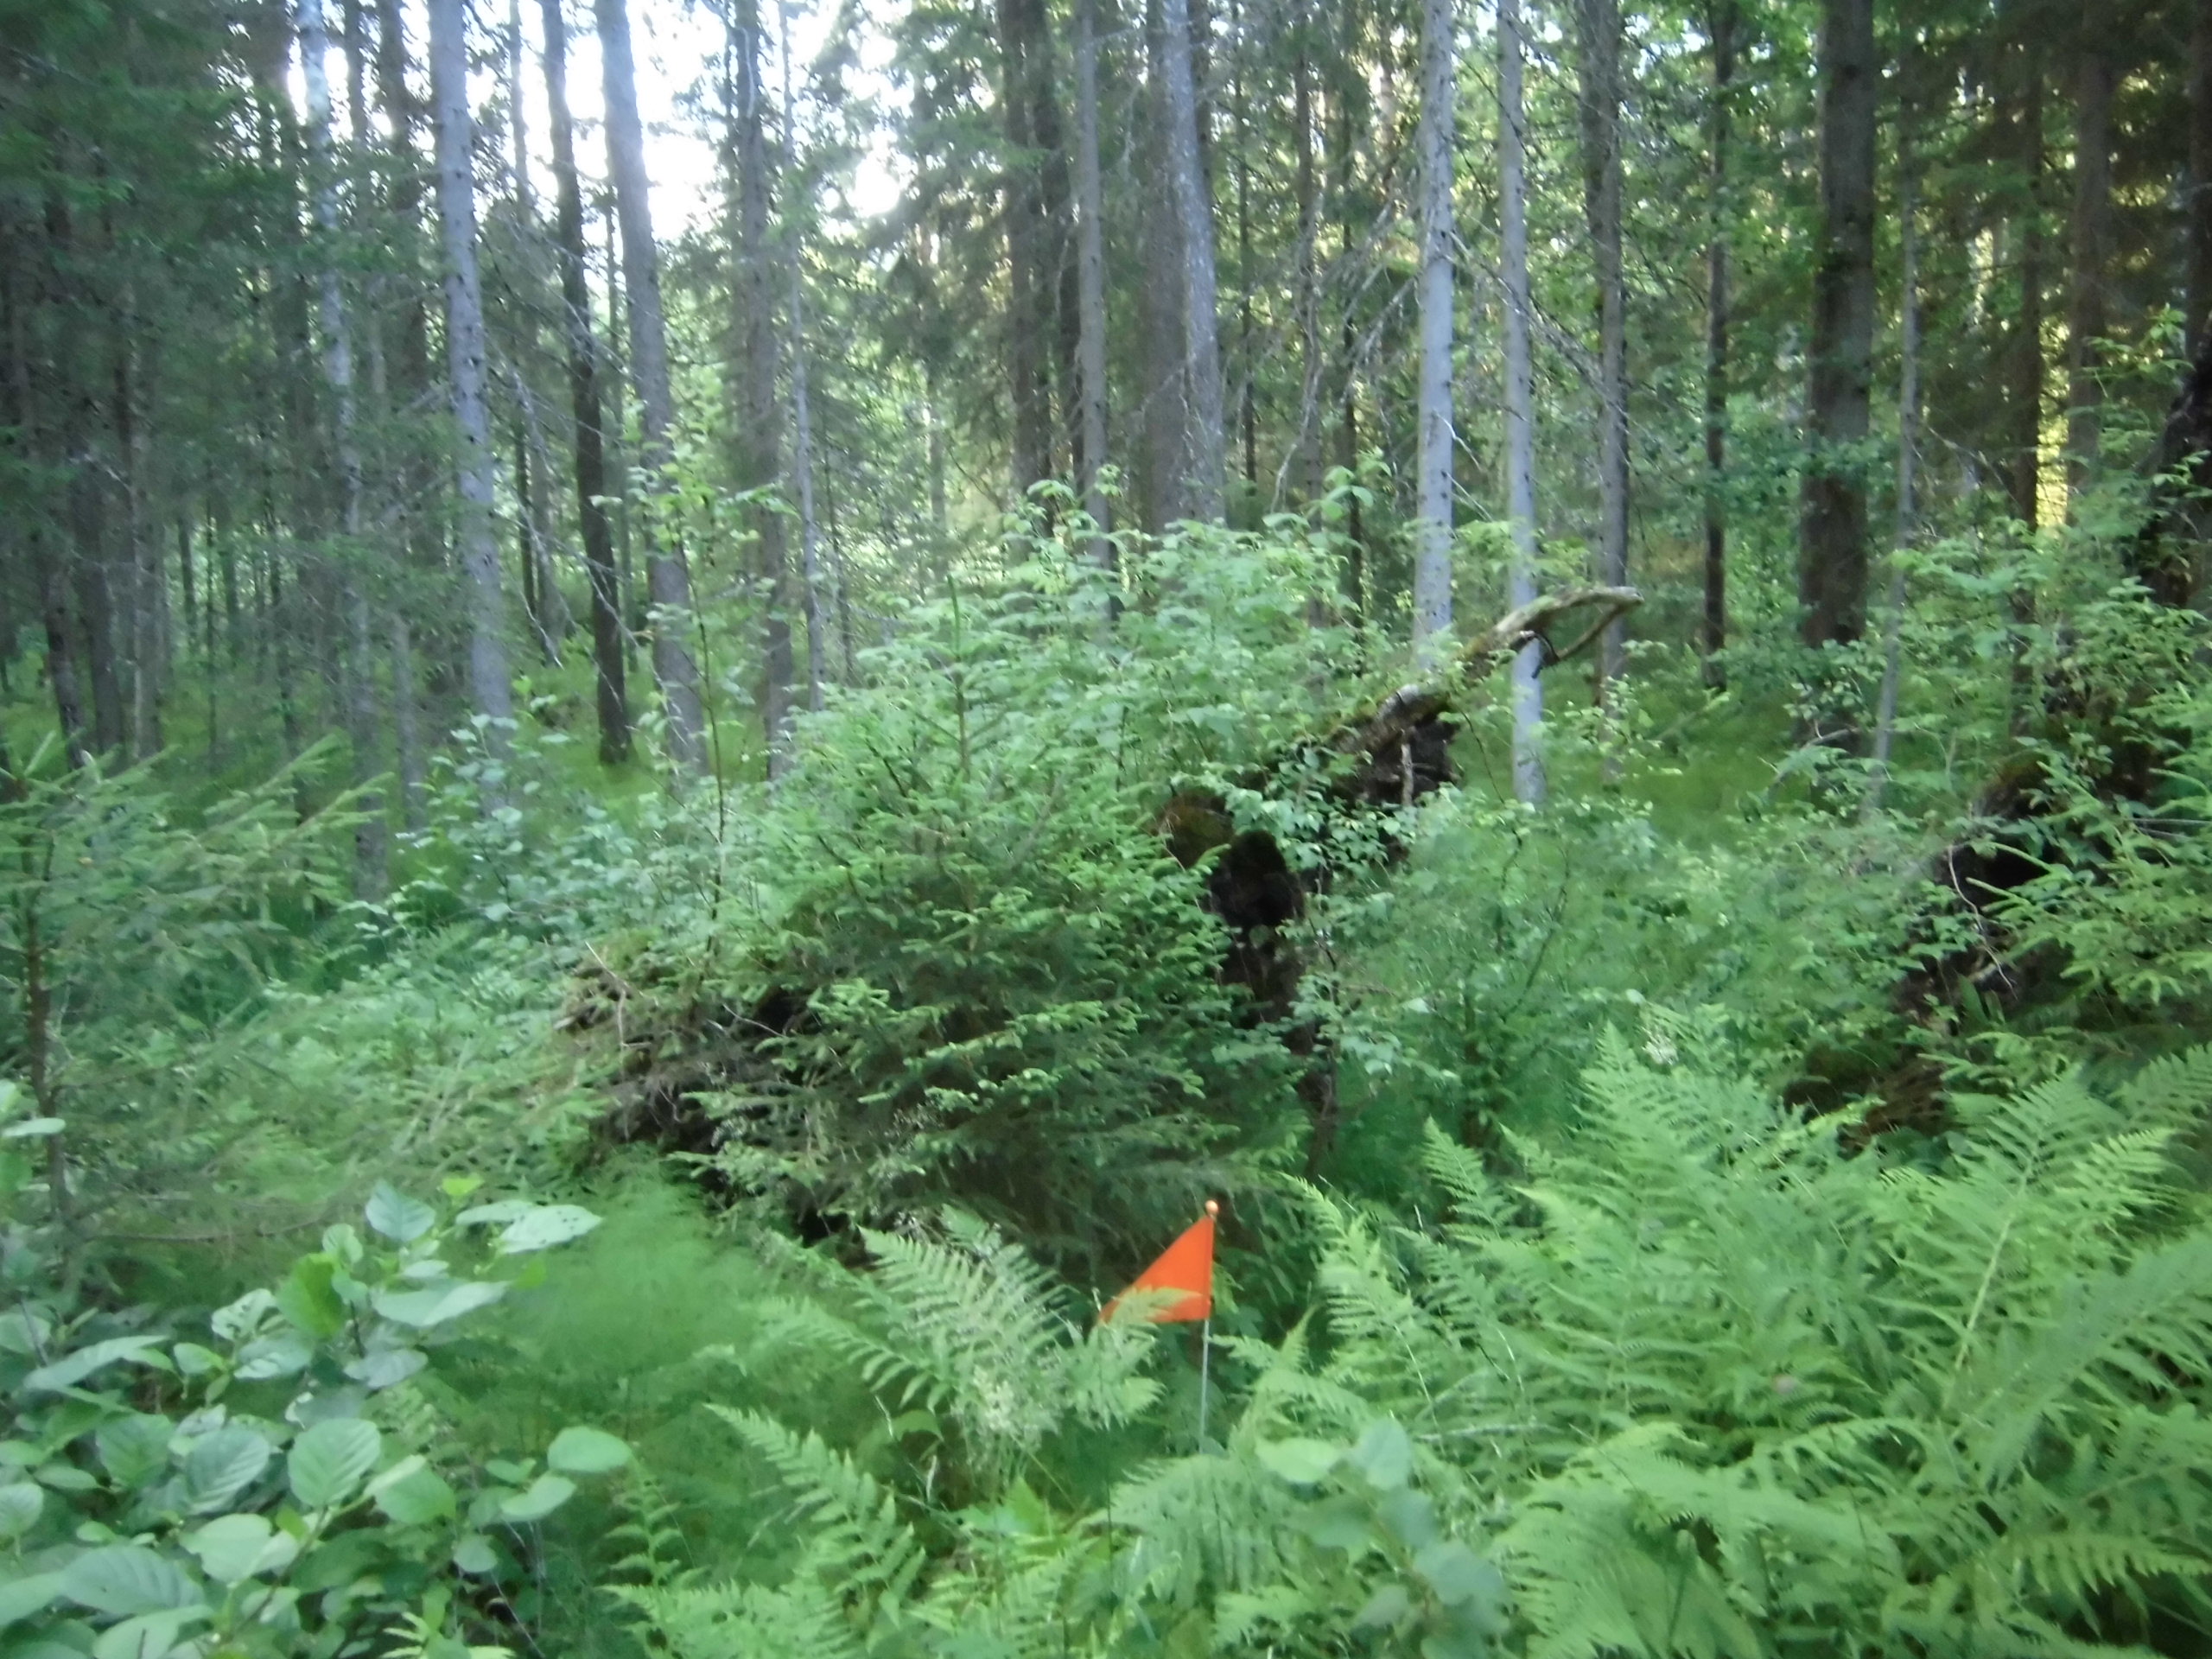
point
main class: Woodland
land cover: Spruce dominated mixed woodland
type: boreal forest
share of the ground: 50 - 75 %
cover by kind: coniferous forest trees 35 %, broadleaved forest trees 25 %, herbaceous plants 20 %, shrubs 10 %, lichens and mosses 10 %
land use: Forestry
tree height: > 5 m
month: July
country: SE
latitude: 57.3964
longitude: 15.2383
